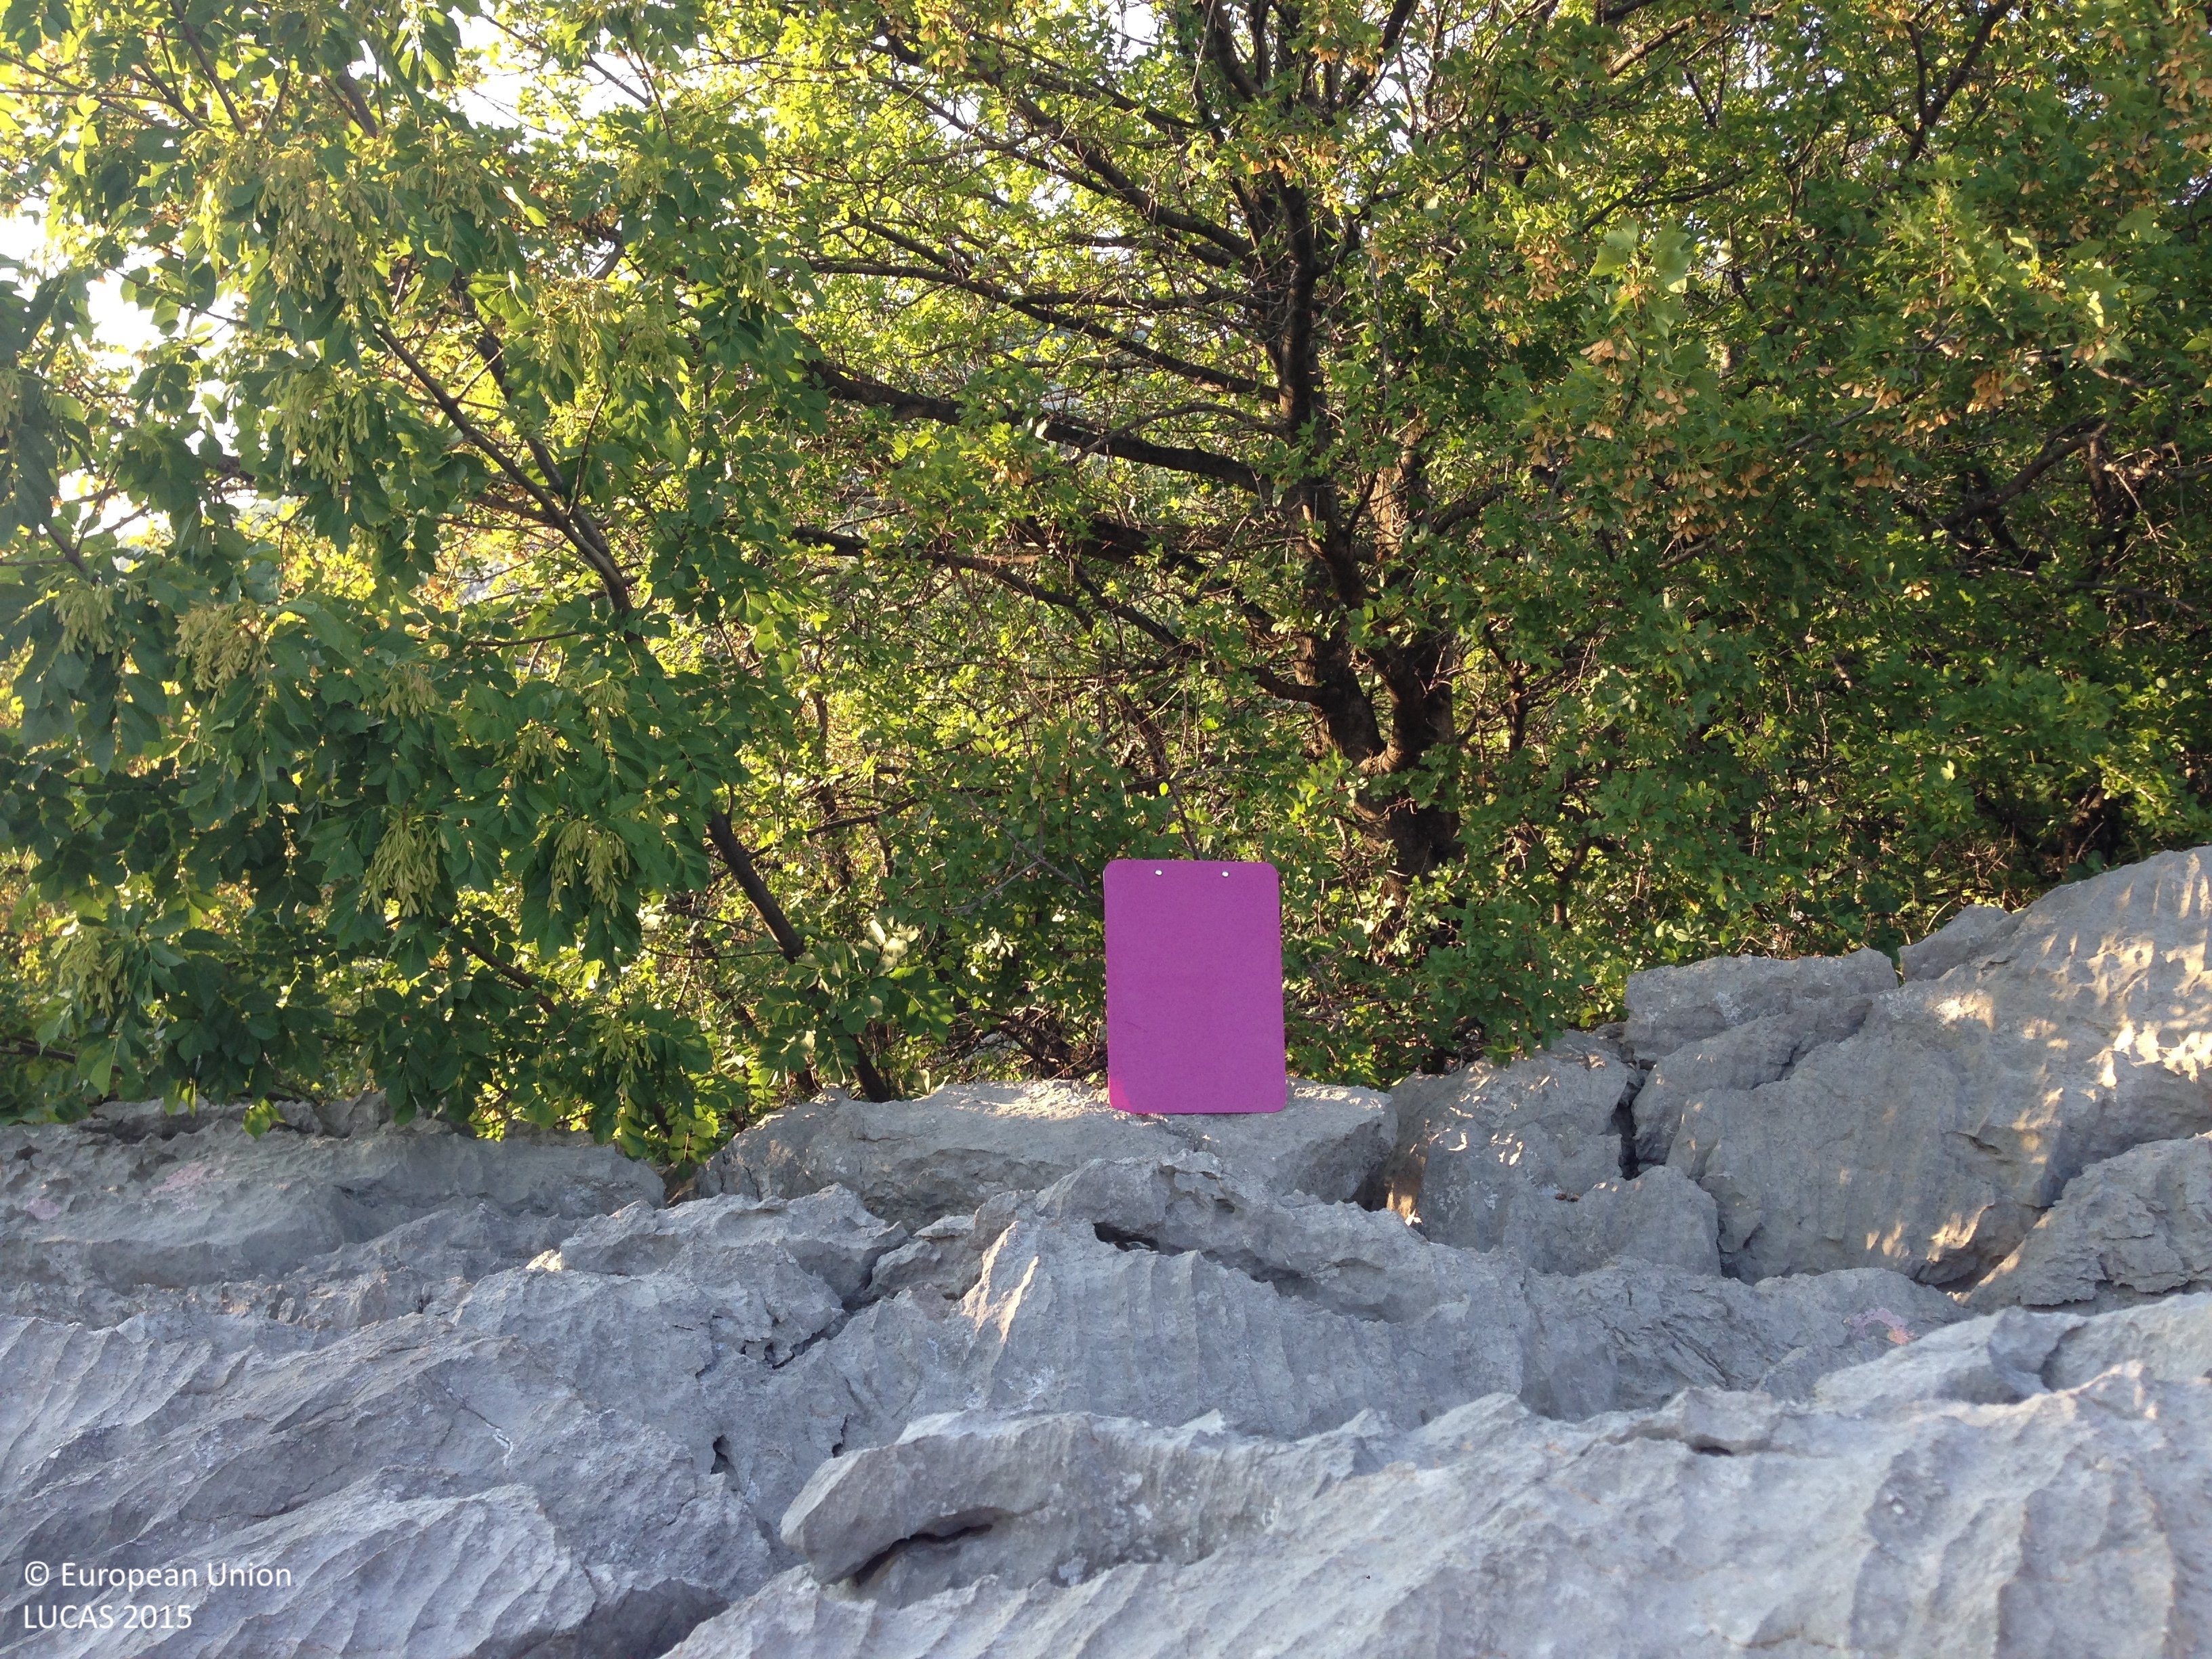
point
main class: Woodland
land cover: Broadleaved woodland
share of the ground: 25 - 50 %
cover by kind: unconsolidated bare surface 45 %, broadleaved forest trees 25 %, shrubs 10 %, herbaceous plants 10 %, consolidated bare surface 10 %
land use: Semi-natural and natural areas not in use
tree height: < 5 m
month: July
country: HR
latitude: 44.5341
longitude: 15.0646
